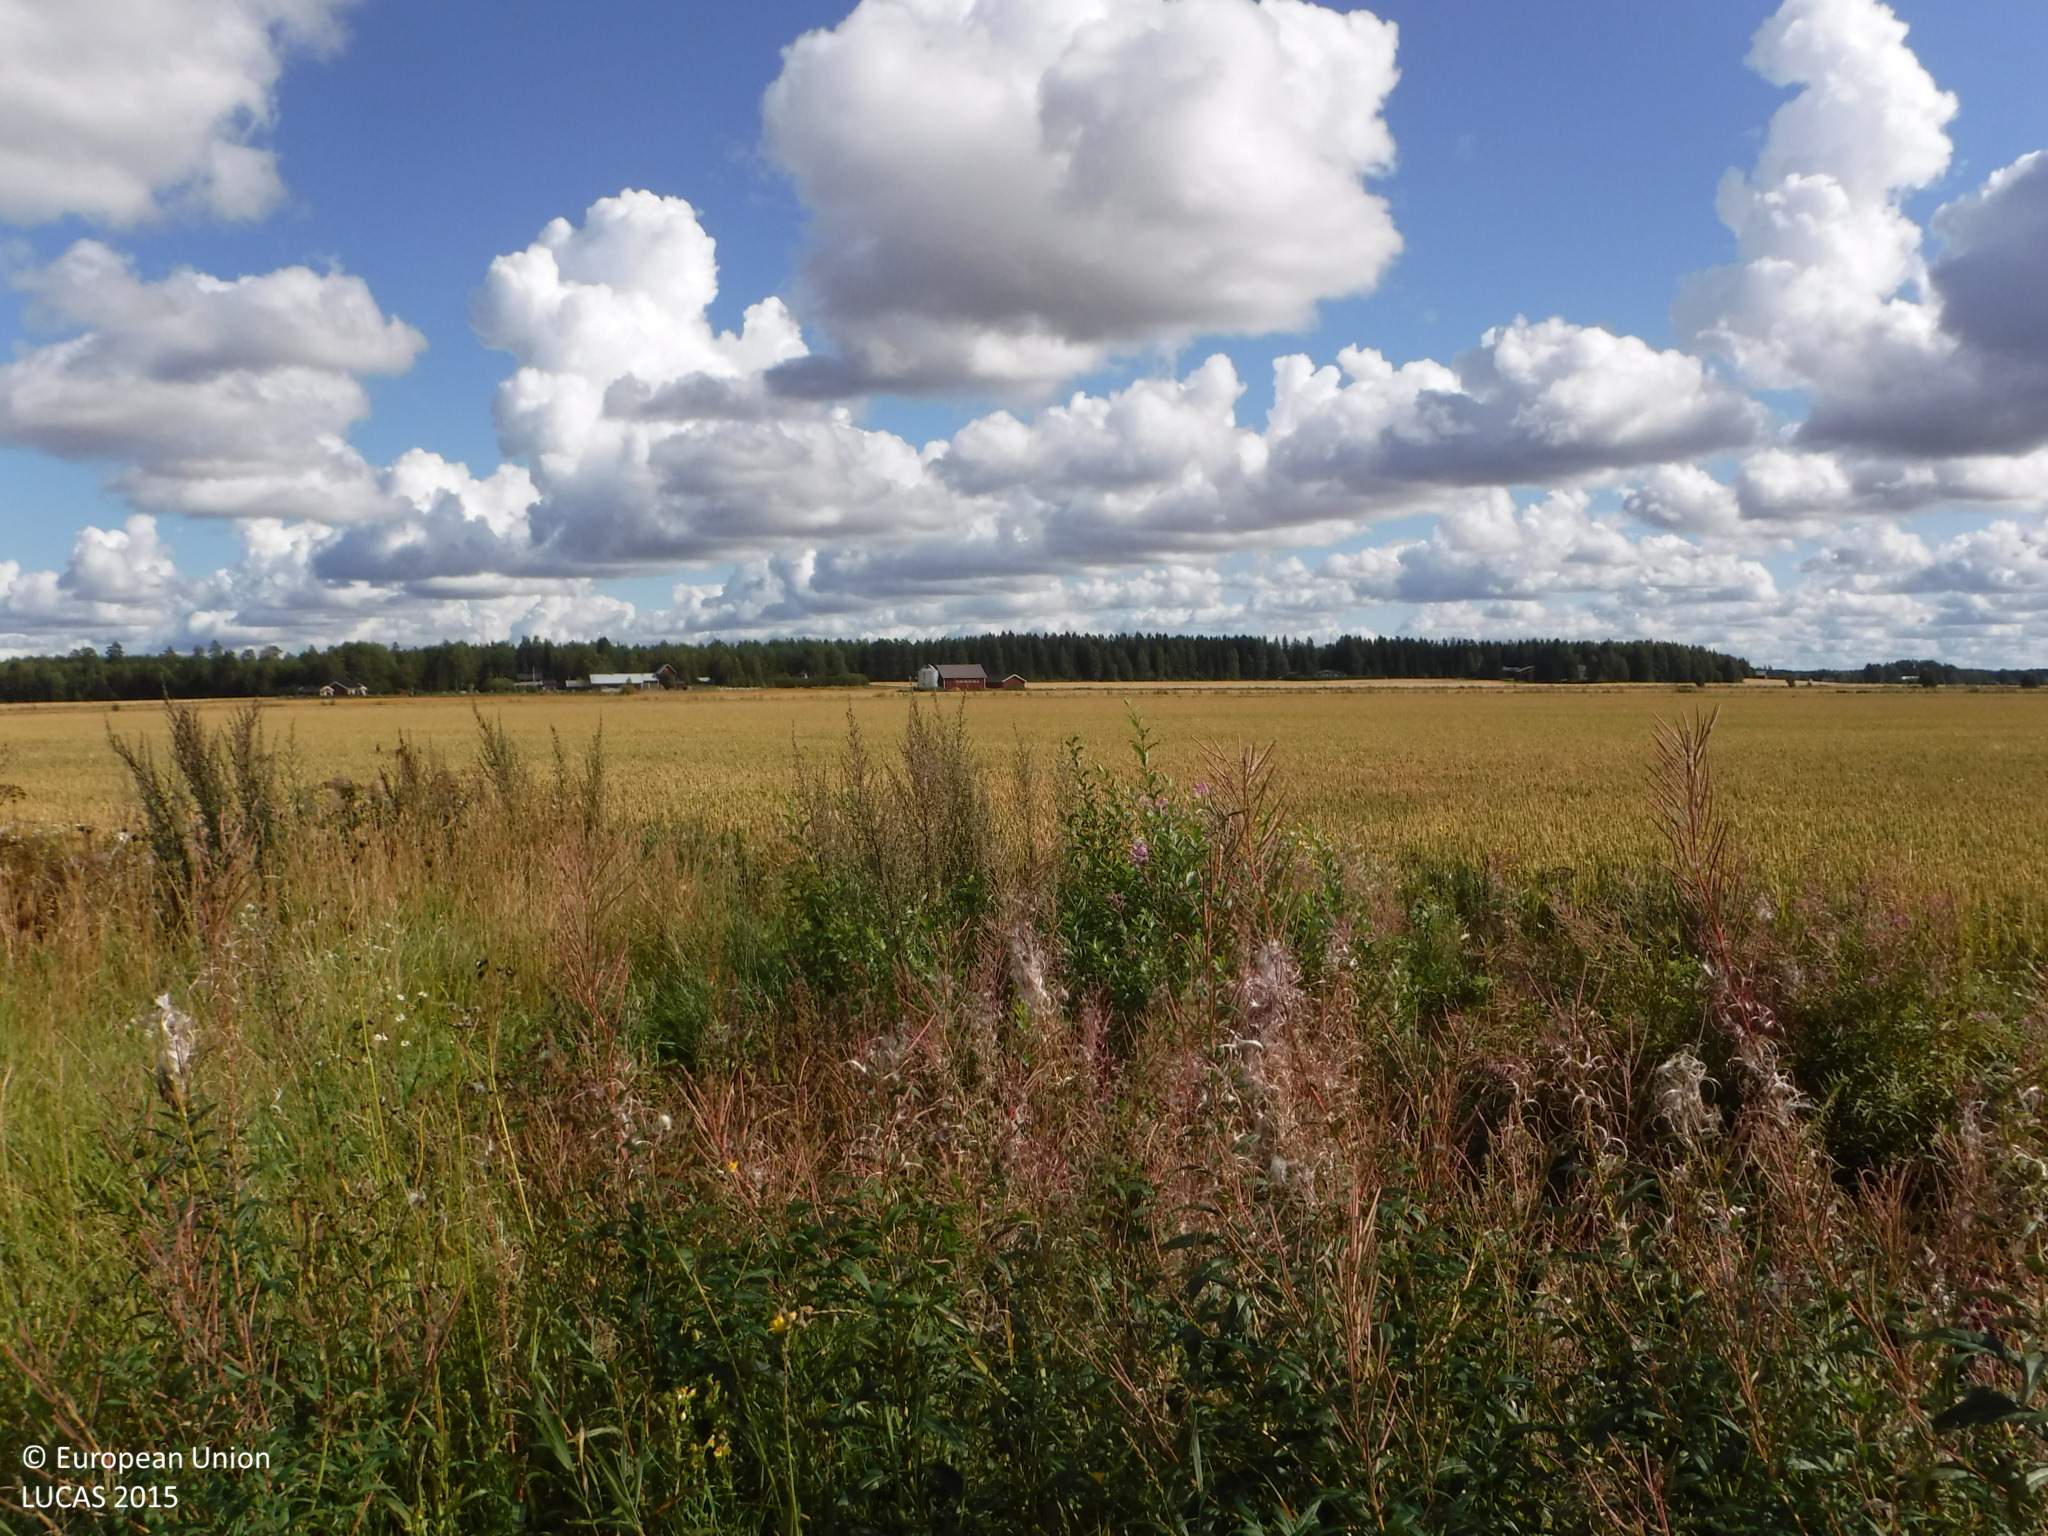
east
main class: Cropland
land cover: Common wheat
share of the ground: > 75 %
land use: Agriculture (excluding fallow land and kitchen gardens)
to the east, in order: Common wheat; Grassland without tree/shrub cover; Ditches and canals; Shruby margins; Common wheat
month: August
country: FI
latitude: 61.2239
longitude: 21.9196
